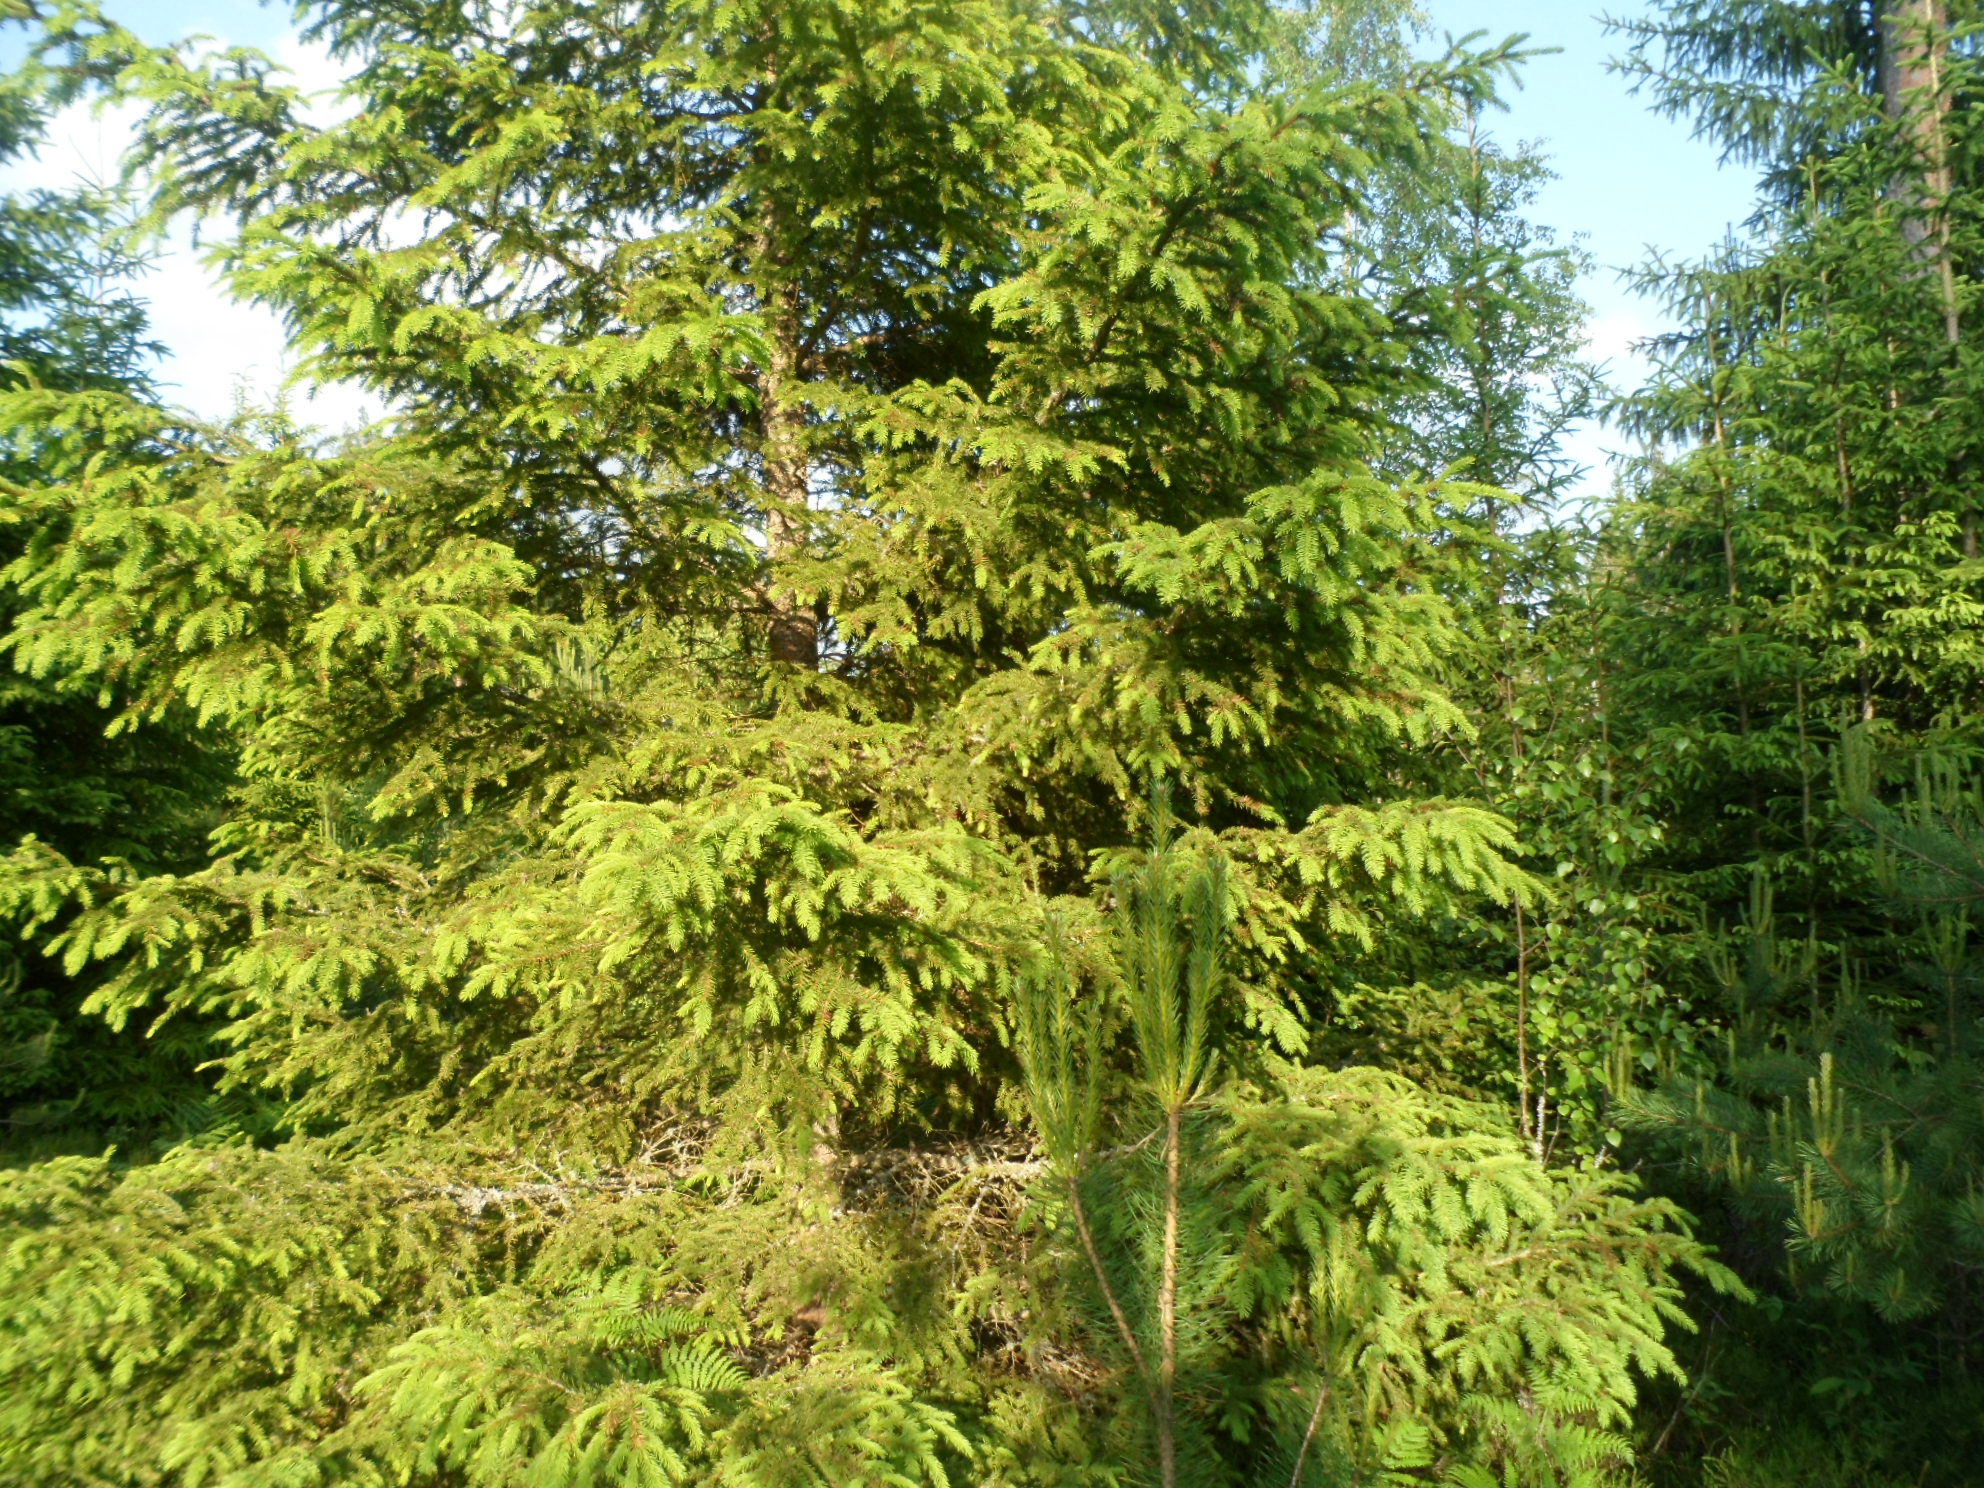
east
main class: Woodland
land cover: Spruce dominated mixed woodland
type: boreal forest
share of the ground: 50 - 75 %
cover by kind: broadleaved forest trees 35 %, coniferous forest trees 30 %, shrubs 15 %, herbaceous plants 10 %, lichens and mosses 10 %
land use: Forestry
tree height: > 5 m
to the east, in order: Spruce dominated mixed woodland; Pine dominated mixed woodland; Spruce dominated coniferous woodland; Pine dominated mixed woodland
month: June
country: SE
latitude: 57.0990
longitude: 15.4613
